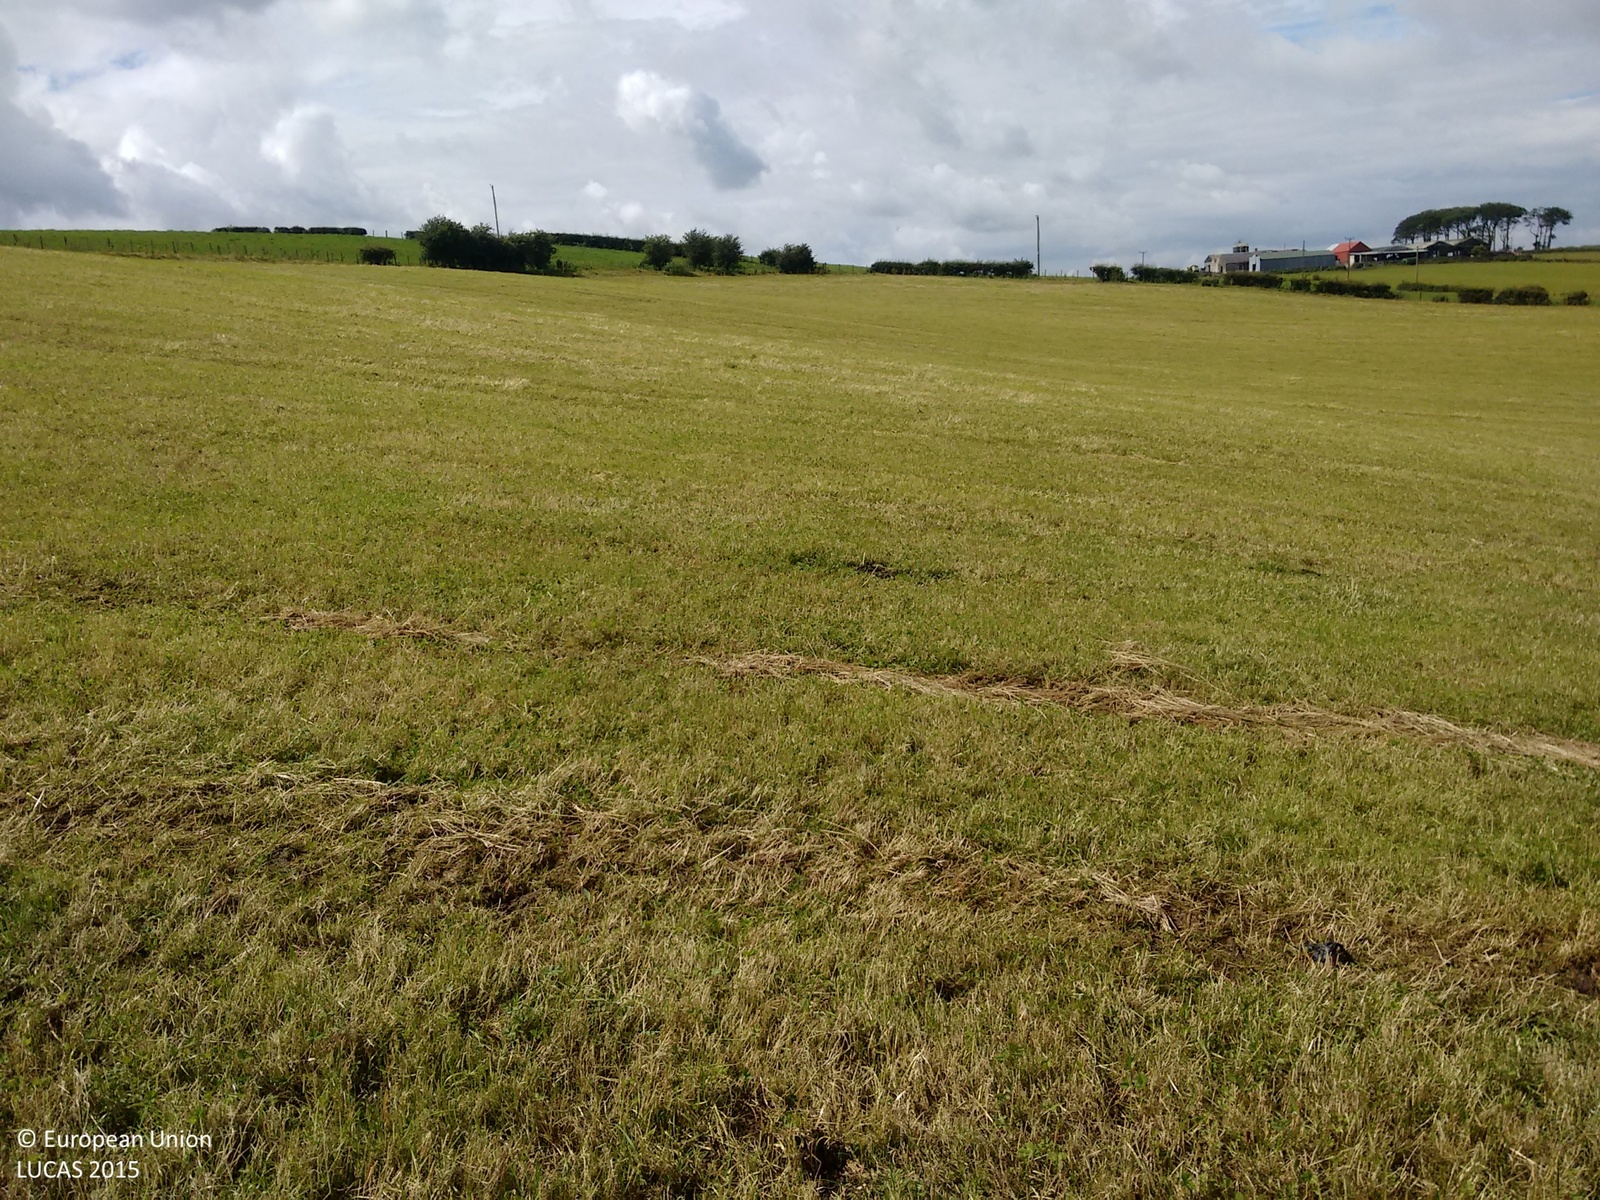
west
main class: Grassland
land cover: Grassland without tree/shrub cover
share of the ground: > 75 %
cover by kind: herbaceous plants 100 %
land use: Agriculture (excluding fallow land and kitchen gardens)
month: August
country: GB
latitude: 55.5898
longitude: -4.3934
